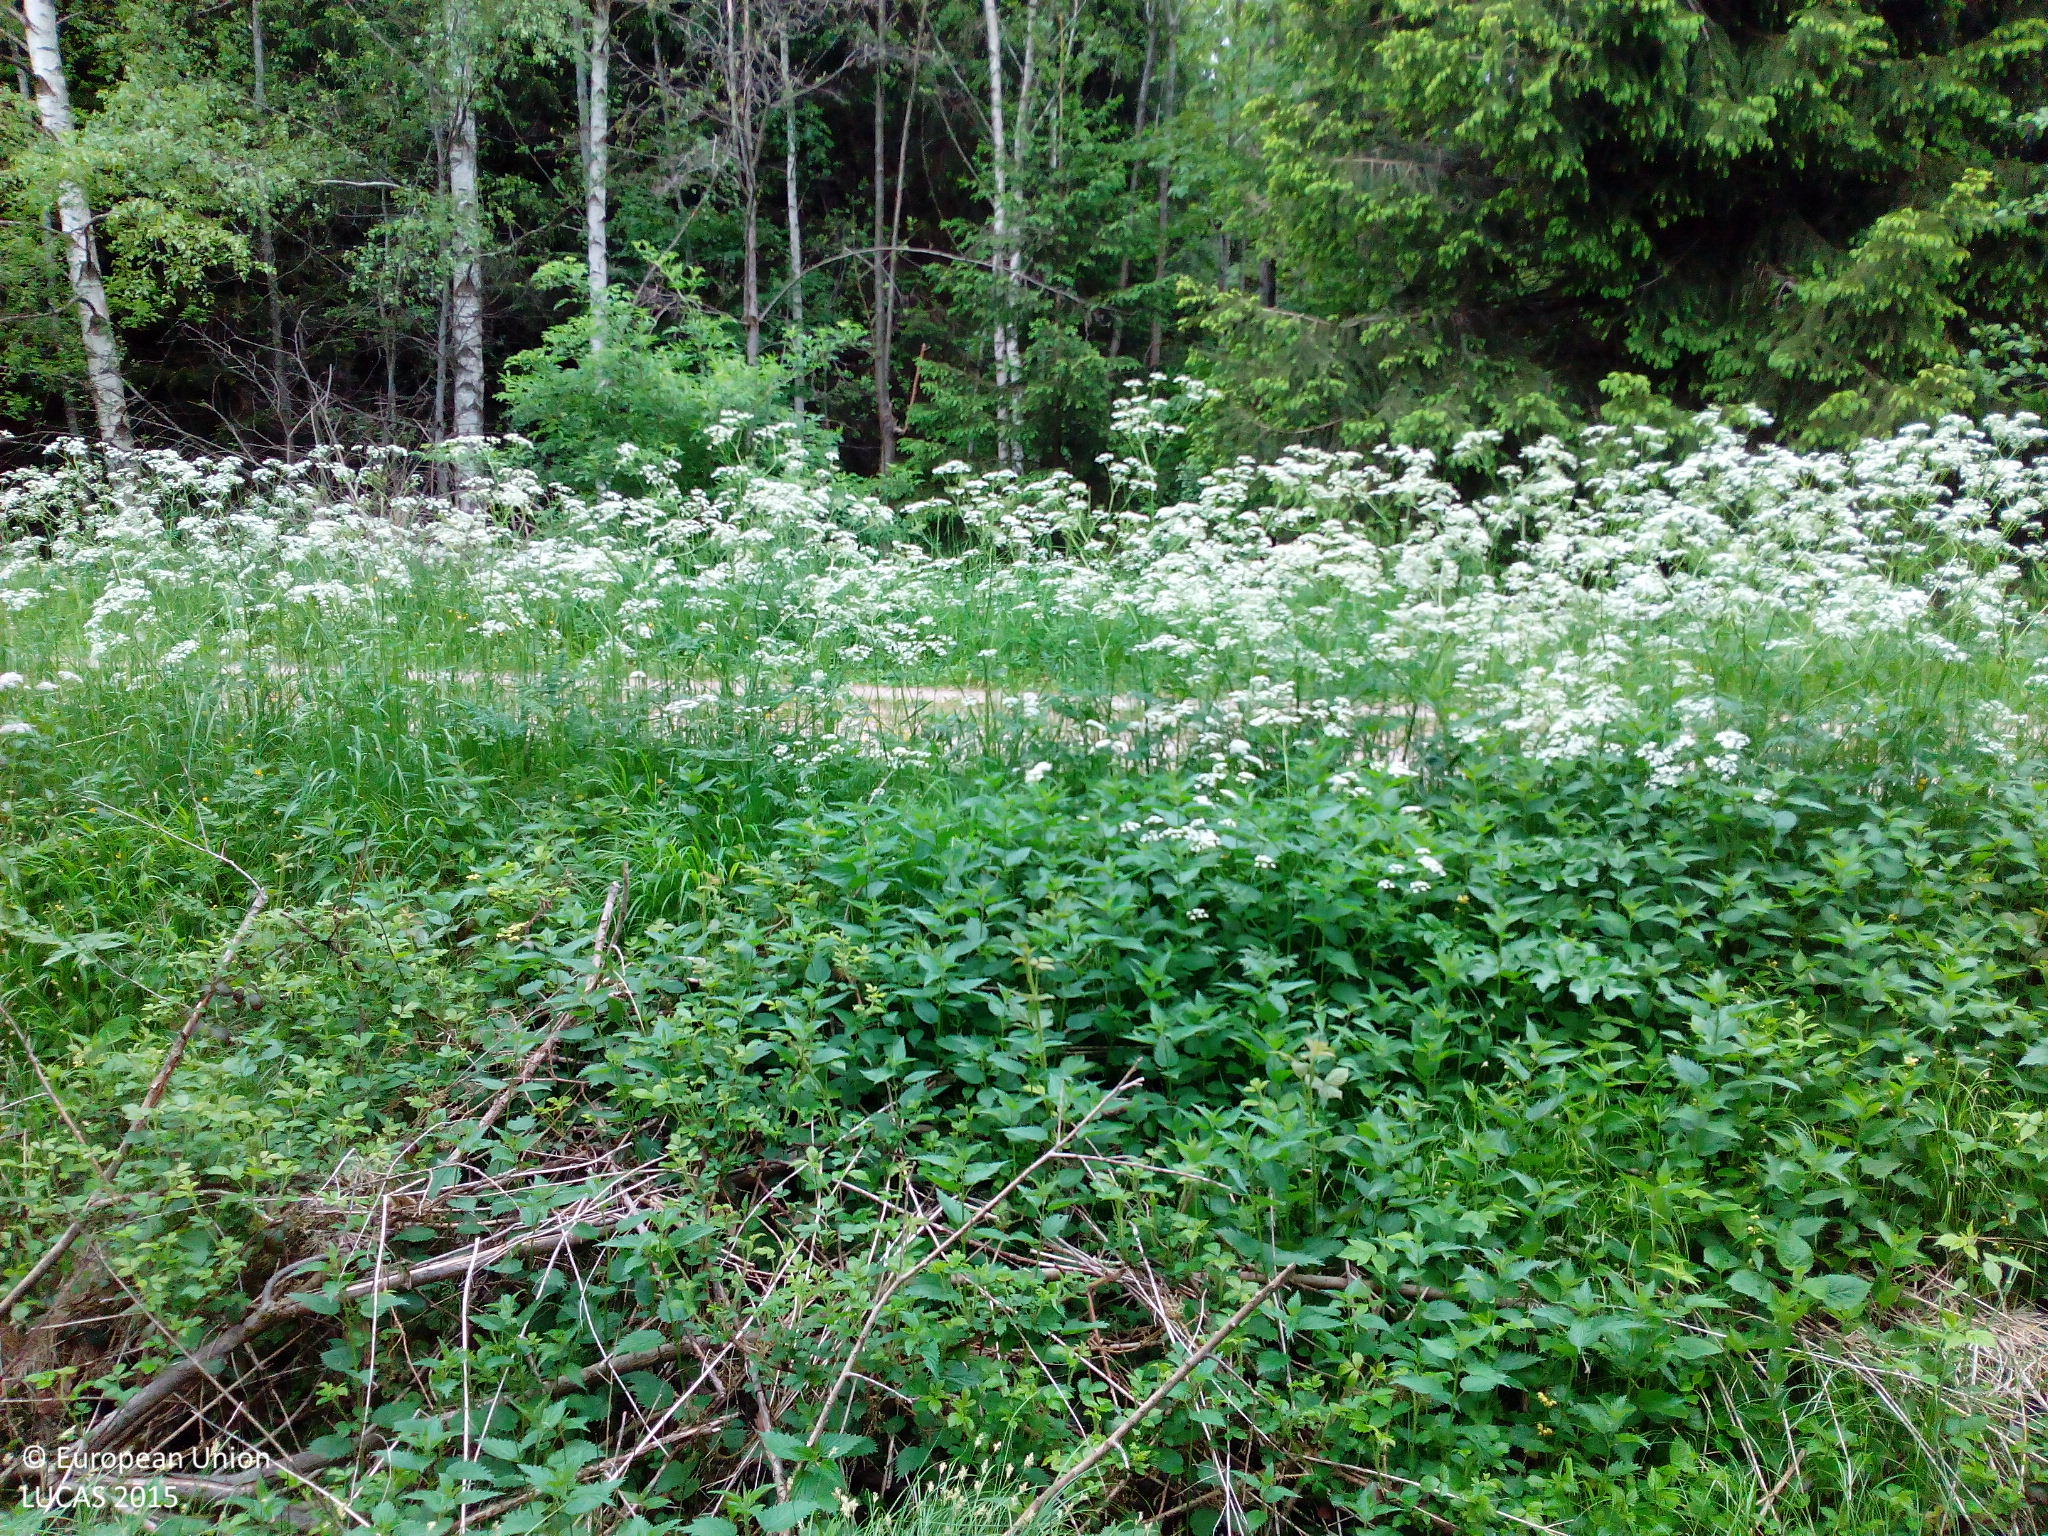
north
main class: Woodland
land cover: Broadleaved woodland
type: mesophytic deciduous forest
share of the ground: > 75 %
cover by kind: broadleaved forest trees 75 %, herbaceous plants 20 %, coniferous forest trees 5 %
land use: Forestry
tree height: > 5 m
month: May
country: DE
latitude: 48.0436
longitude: 9.9330
